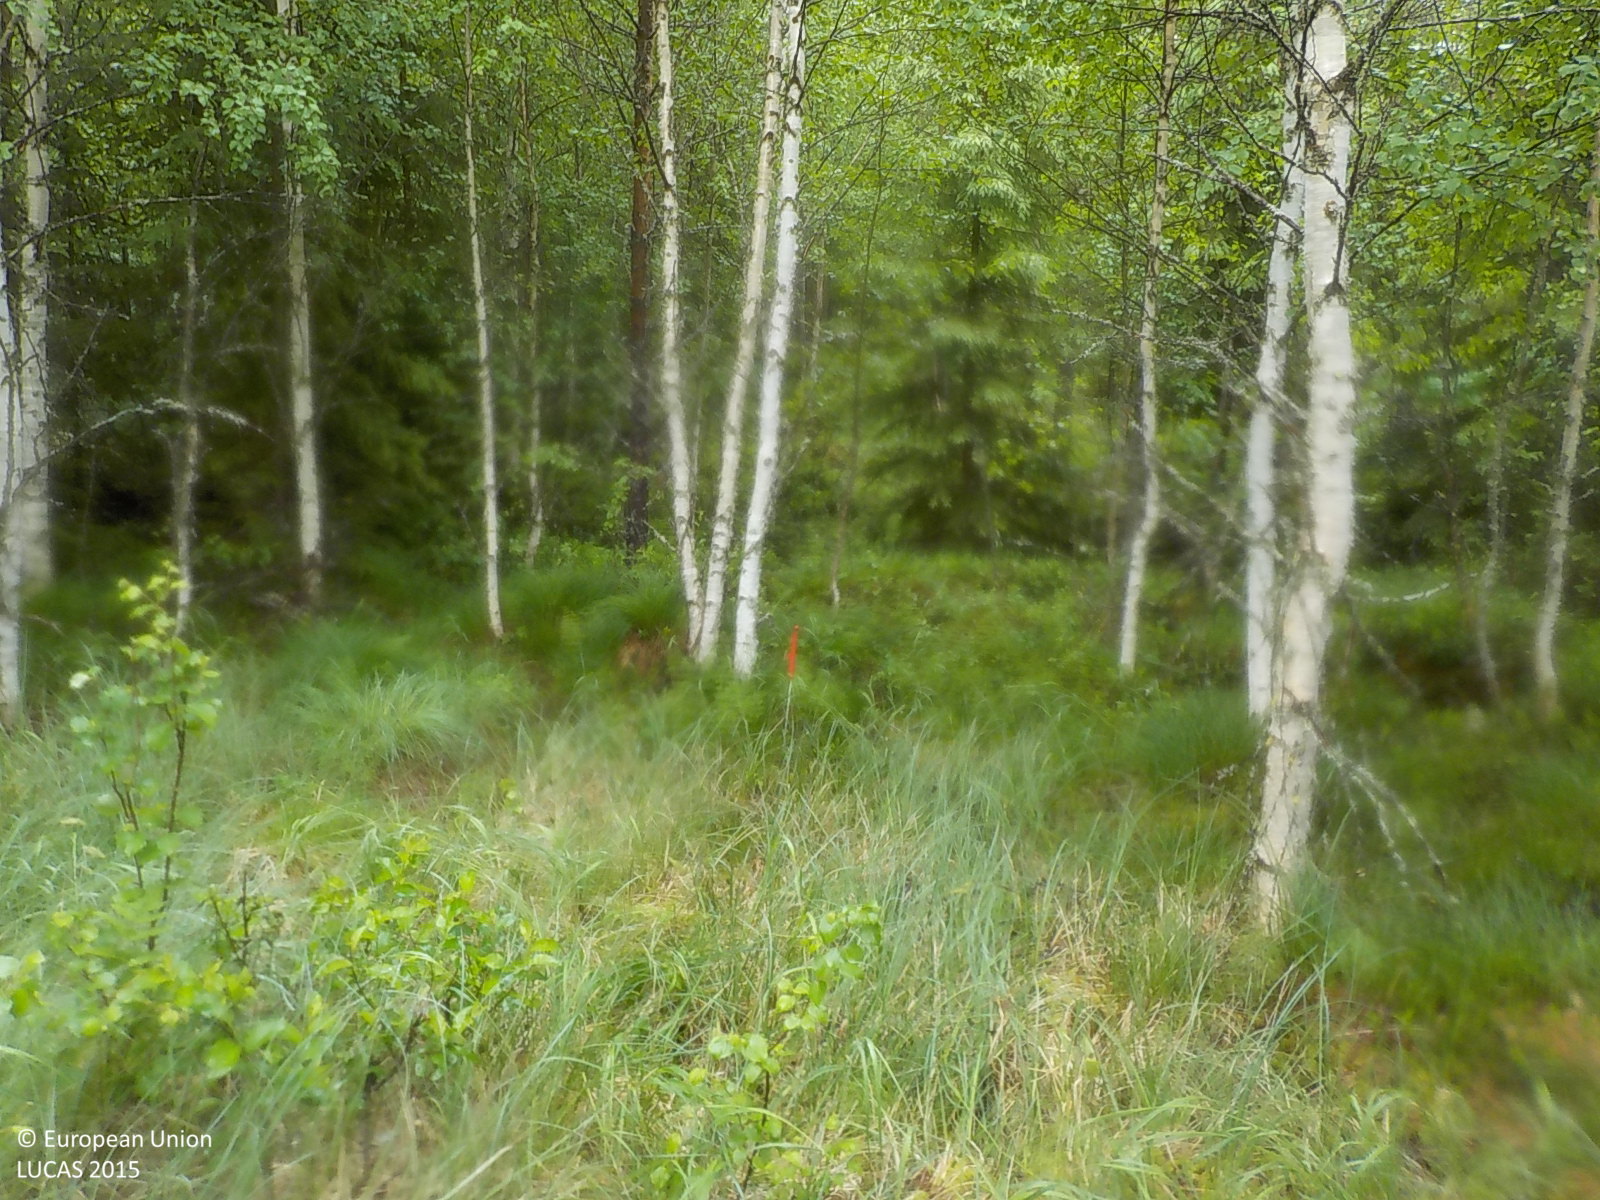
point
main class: Woodland
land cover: Broadleaved woodland
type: boreal forest
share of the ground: 50 - 75 %
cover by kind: broadleaved forest trees 60 %, herbaceous plants 30 %, lichens and mosses 10 %
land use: Forestry
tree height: > 5 m
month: July
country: SE
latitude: 63.1012
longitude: 17.0094
